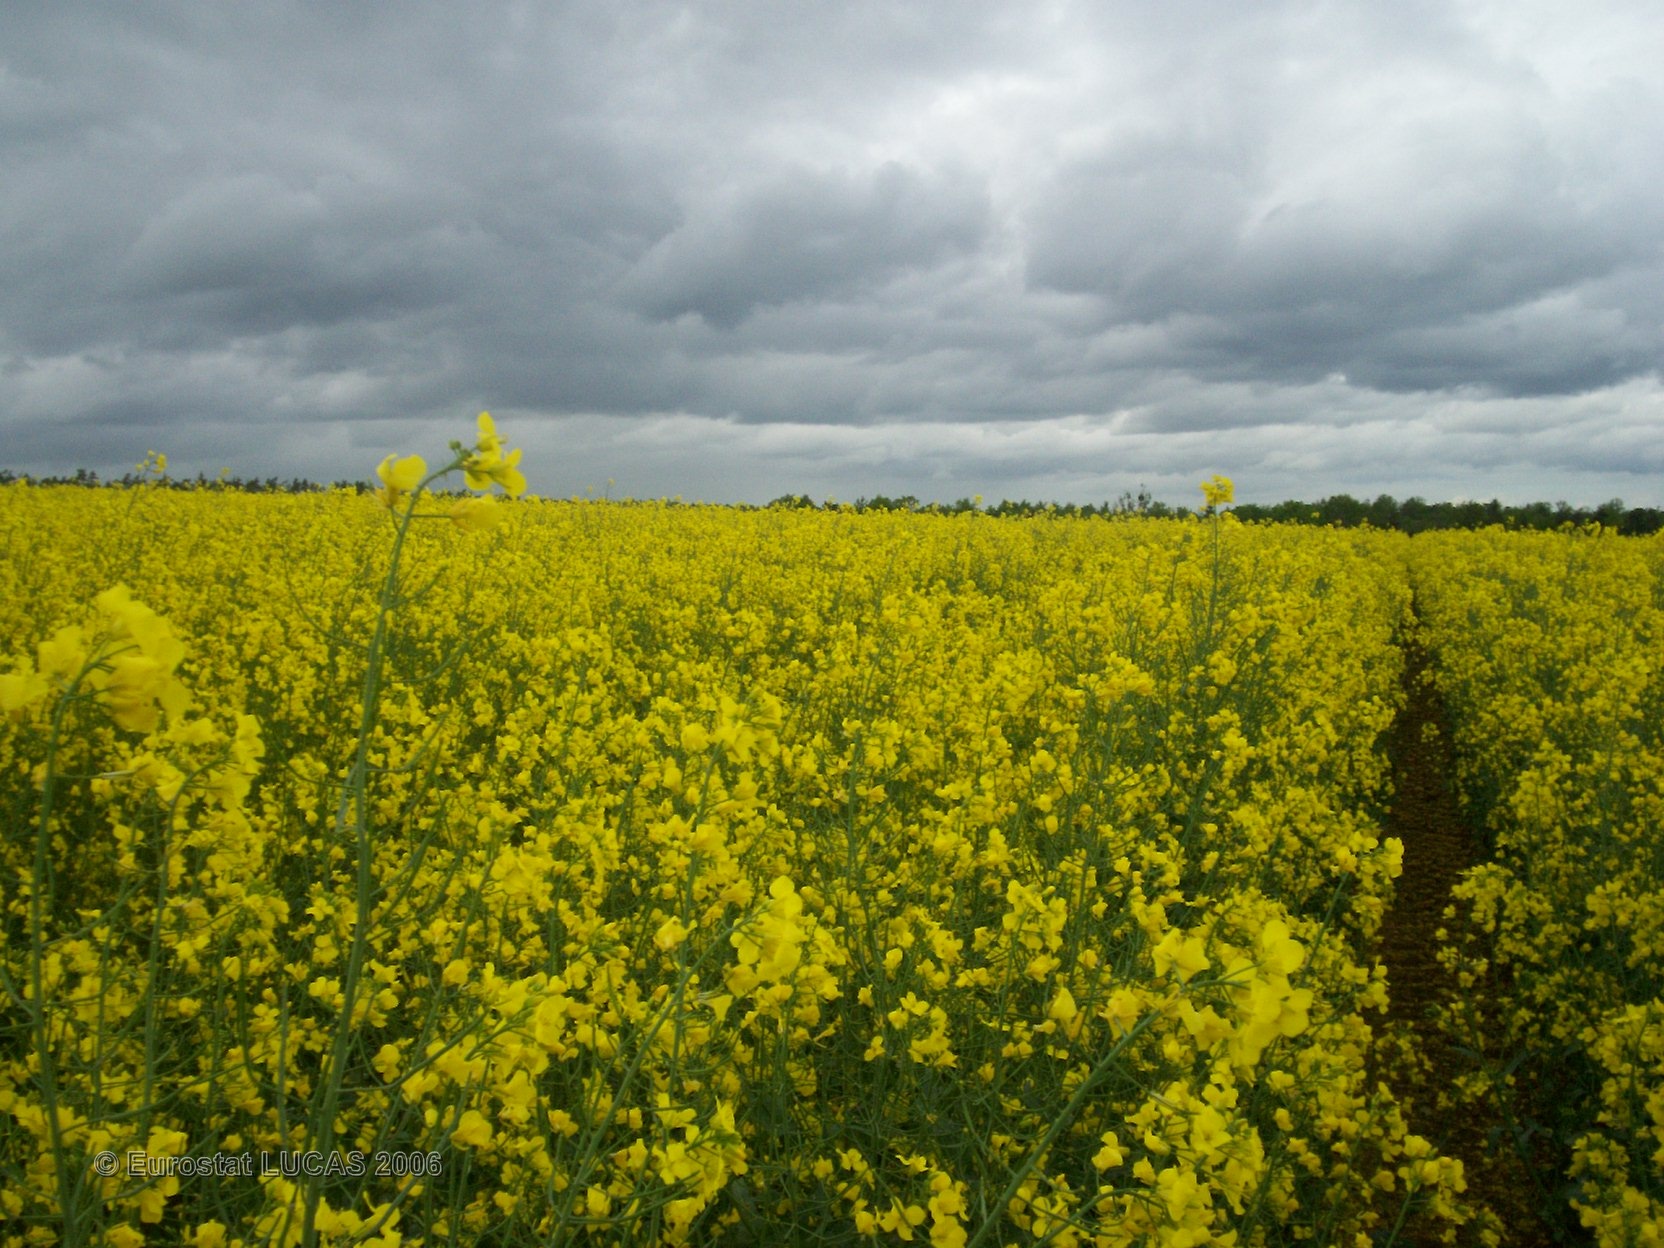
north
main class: Cropland
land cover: Rape and turnip rape
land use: Agriculture (excluding fallow land and kitchen gardens)
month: May
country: FR
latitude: 48.5824
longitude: 5.9738
